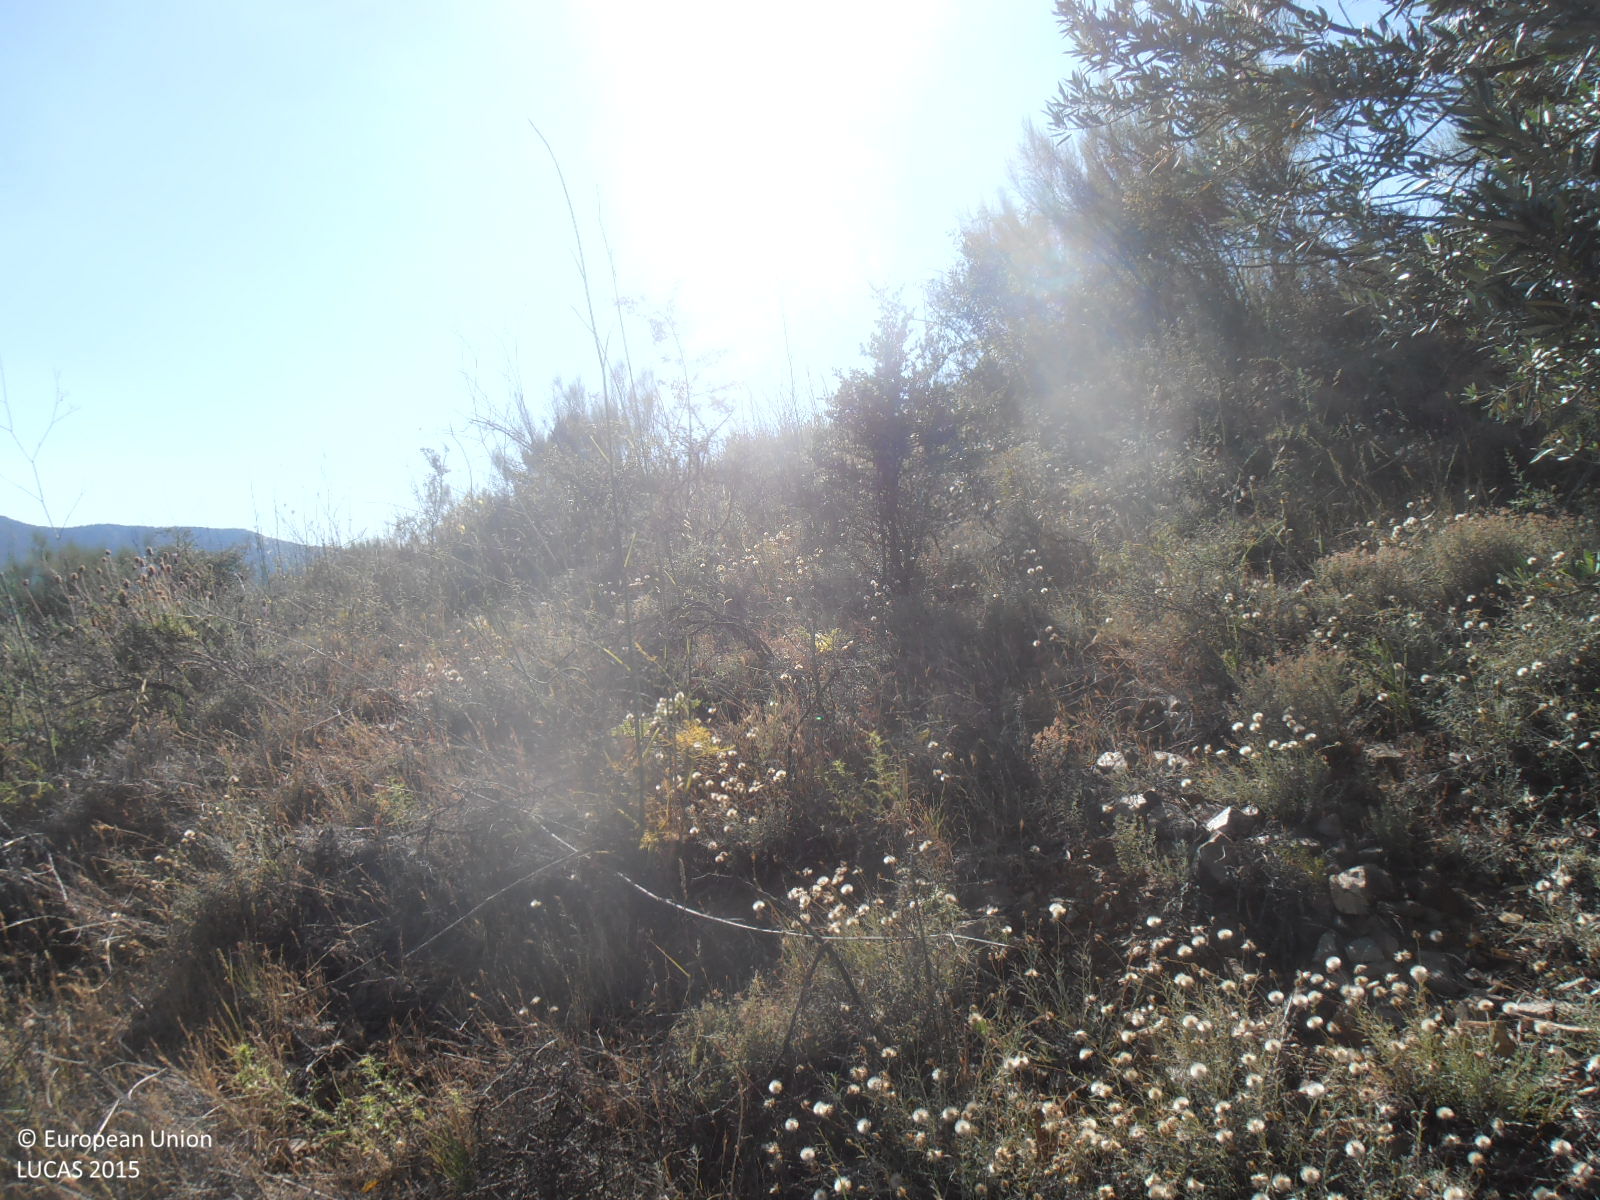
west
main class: Shrubland
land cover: Shrubland without tree cover
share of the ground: > 75 %
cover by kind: shrubs 100 %
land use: Abandoned areas
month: June
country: ES
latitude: 41.3532
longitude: -1.3899
